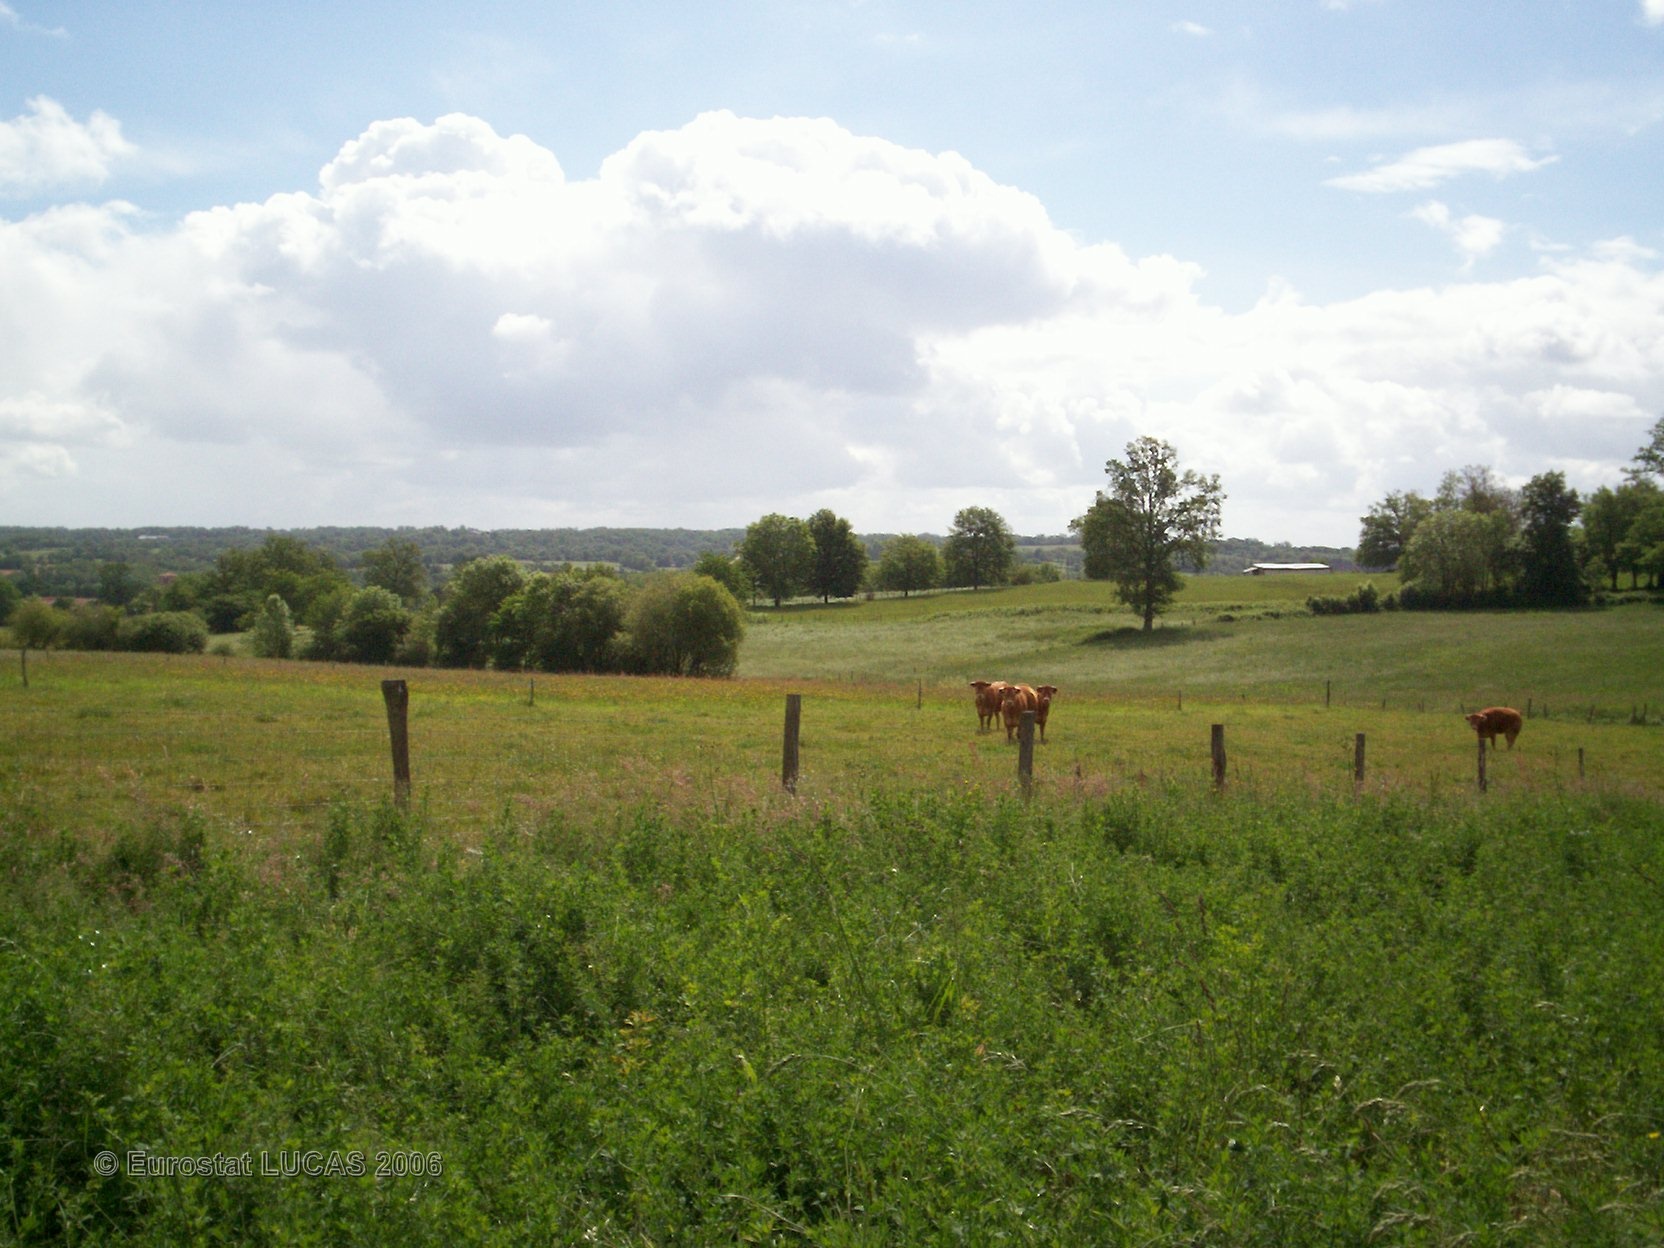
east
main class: Cropland
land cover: Lucerne
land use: Agriculture (excluding fallow land and kitchen gardens)
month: May
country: FR
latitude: 46.0690
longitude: 0.6642
